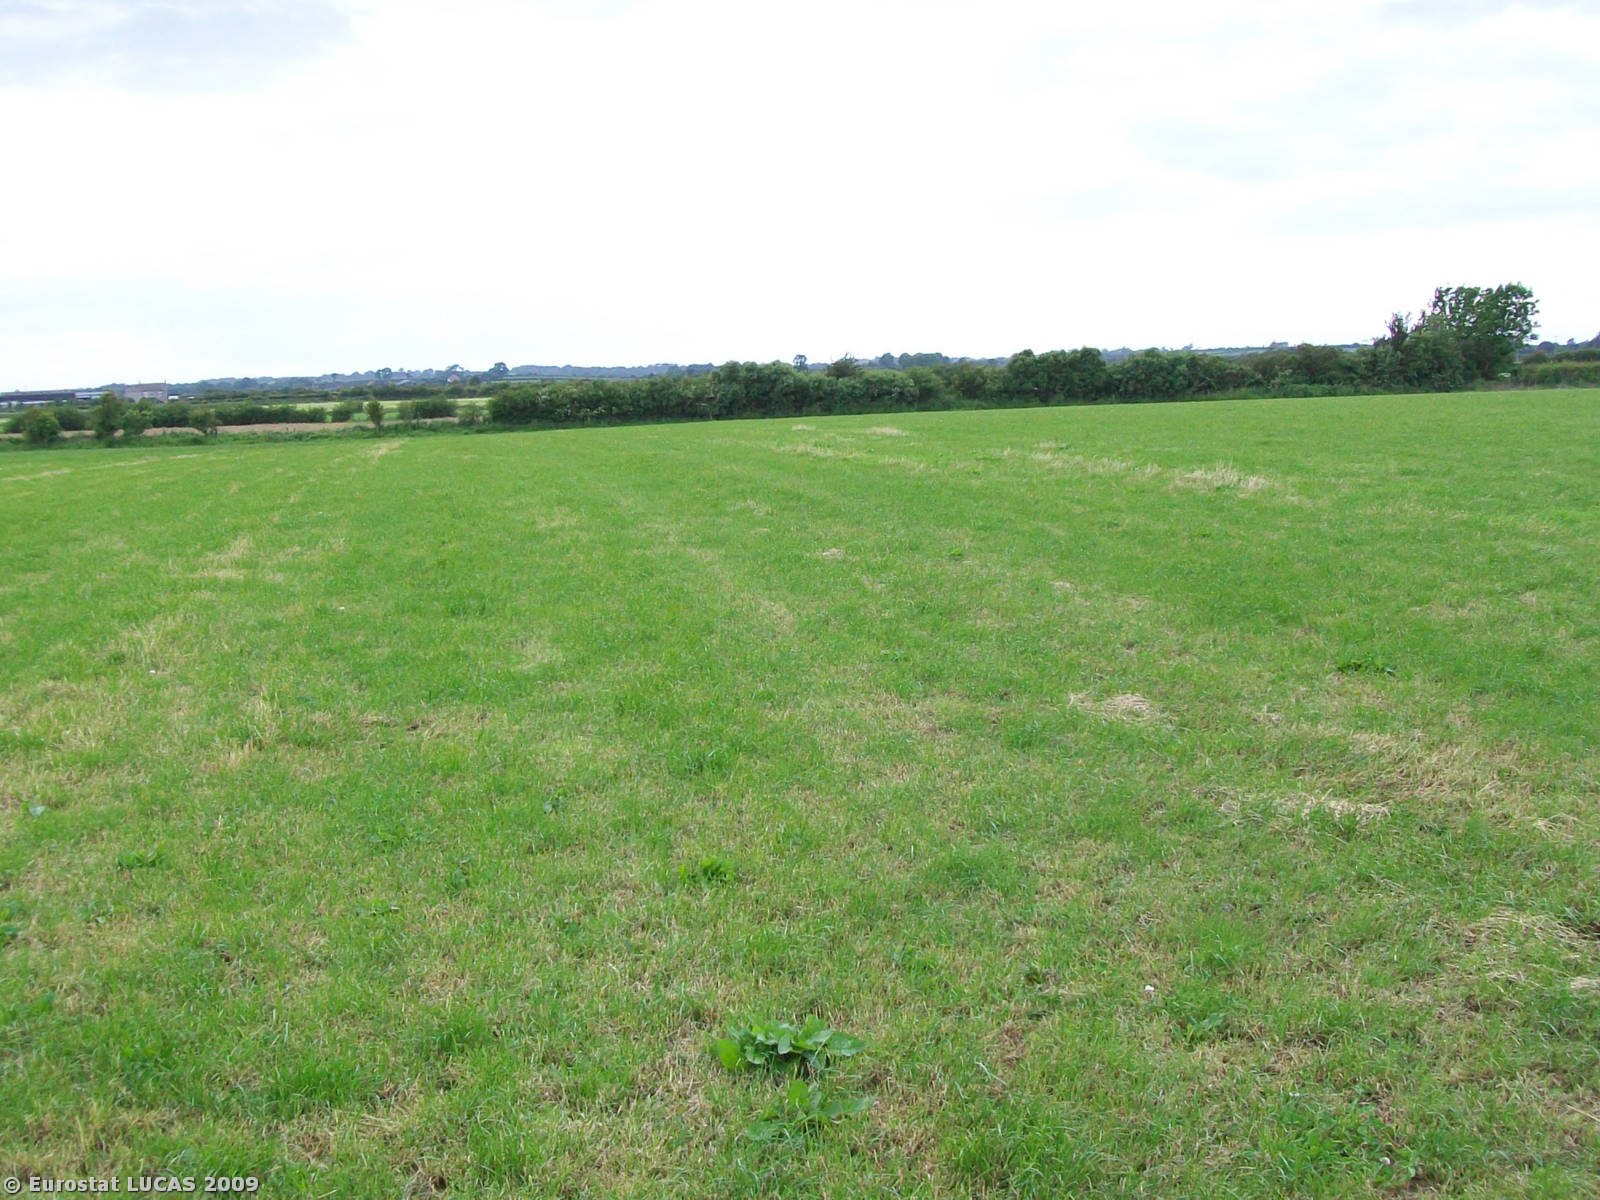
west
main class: Cropland
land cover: Temporary grasslands
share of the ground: > 75 %
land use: Agriculture (excluding fallow land and kitchen gardens)
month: June
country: GB
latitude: 54.8382
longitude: -3.2646
